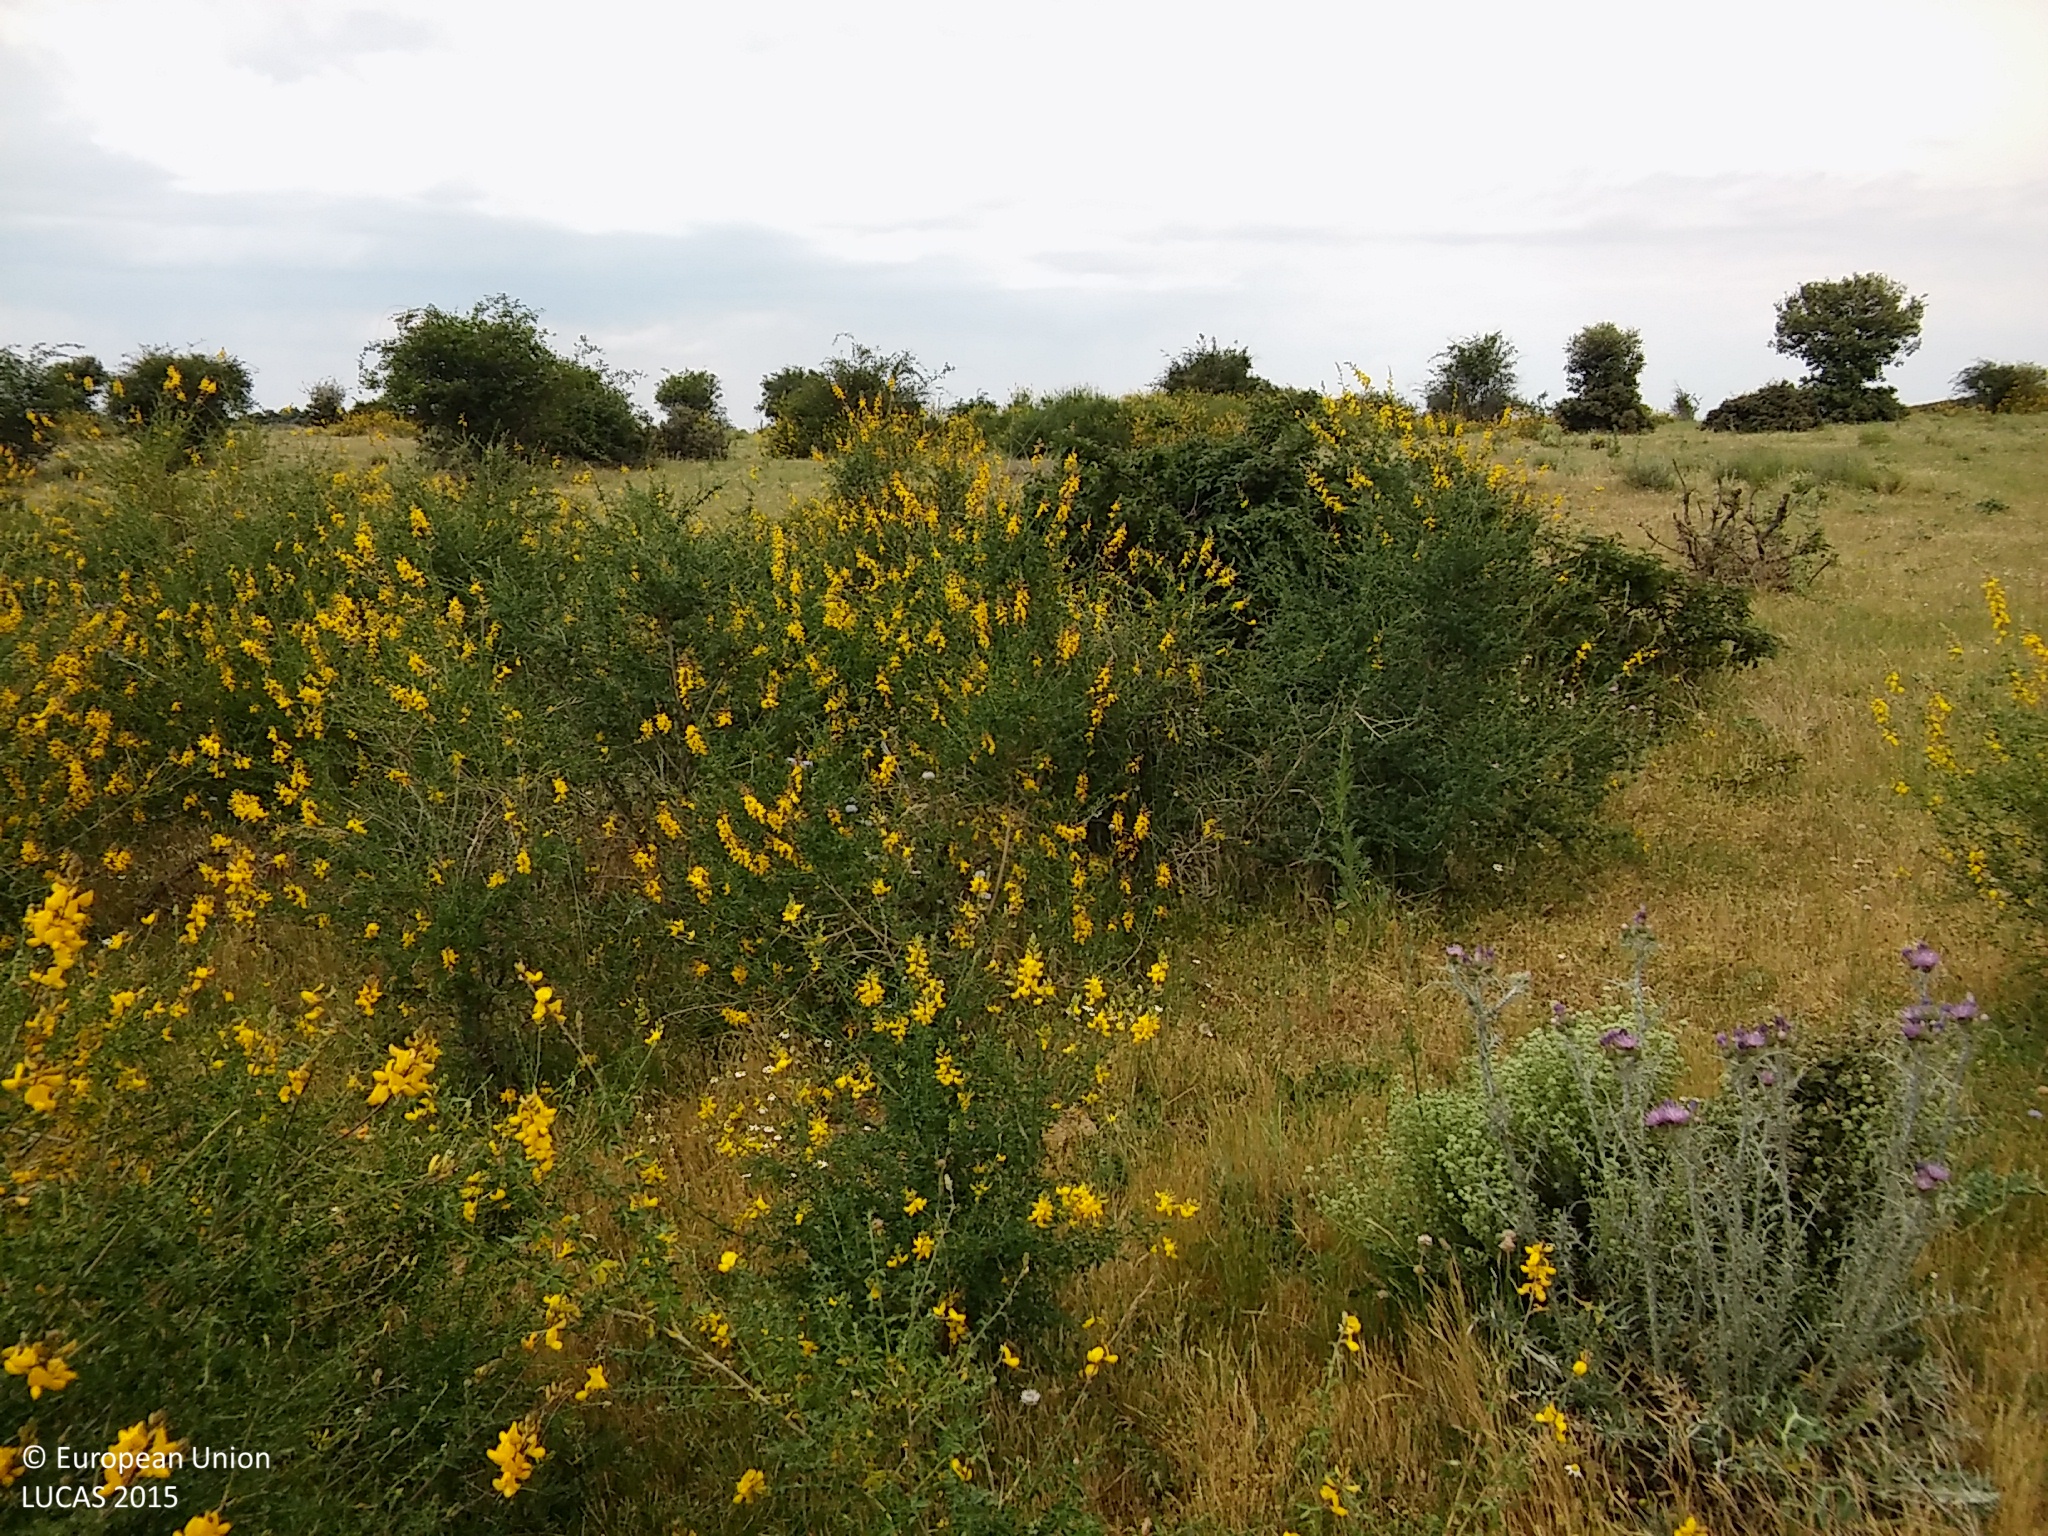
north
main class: Shrubland
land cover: Shrubland without tree cover
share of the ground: 25 - 50 %
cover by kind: herbaceous plants 70 %, shrubs 30 %
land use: Agriculture (excluding fallow land and kitchen gardens)
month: June
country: ES
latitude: 41.2105
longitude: -3.5340
